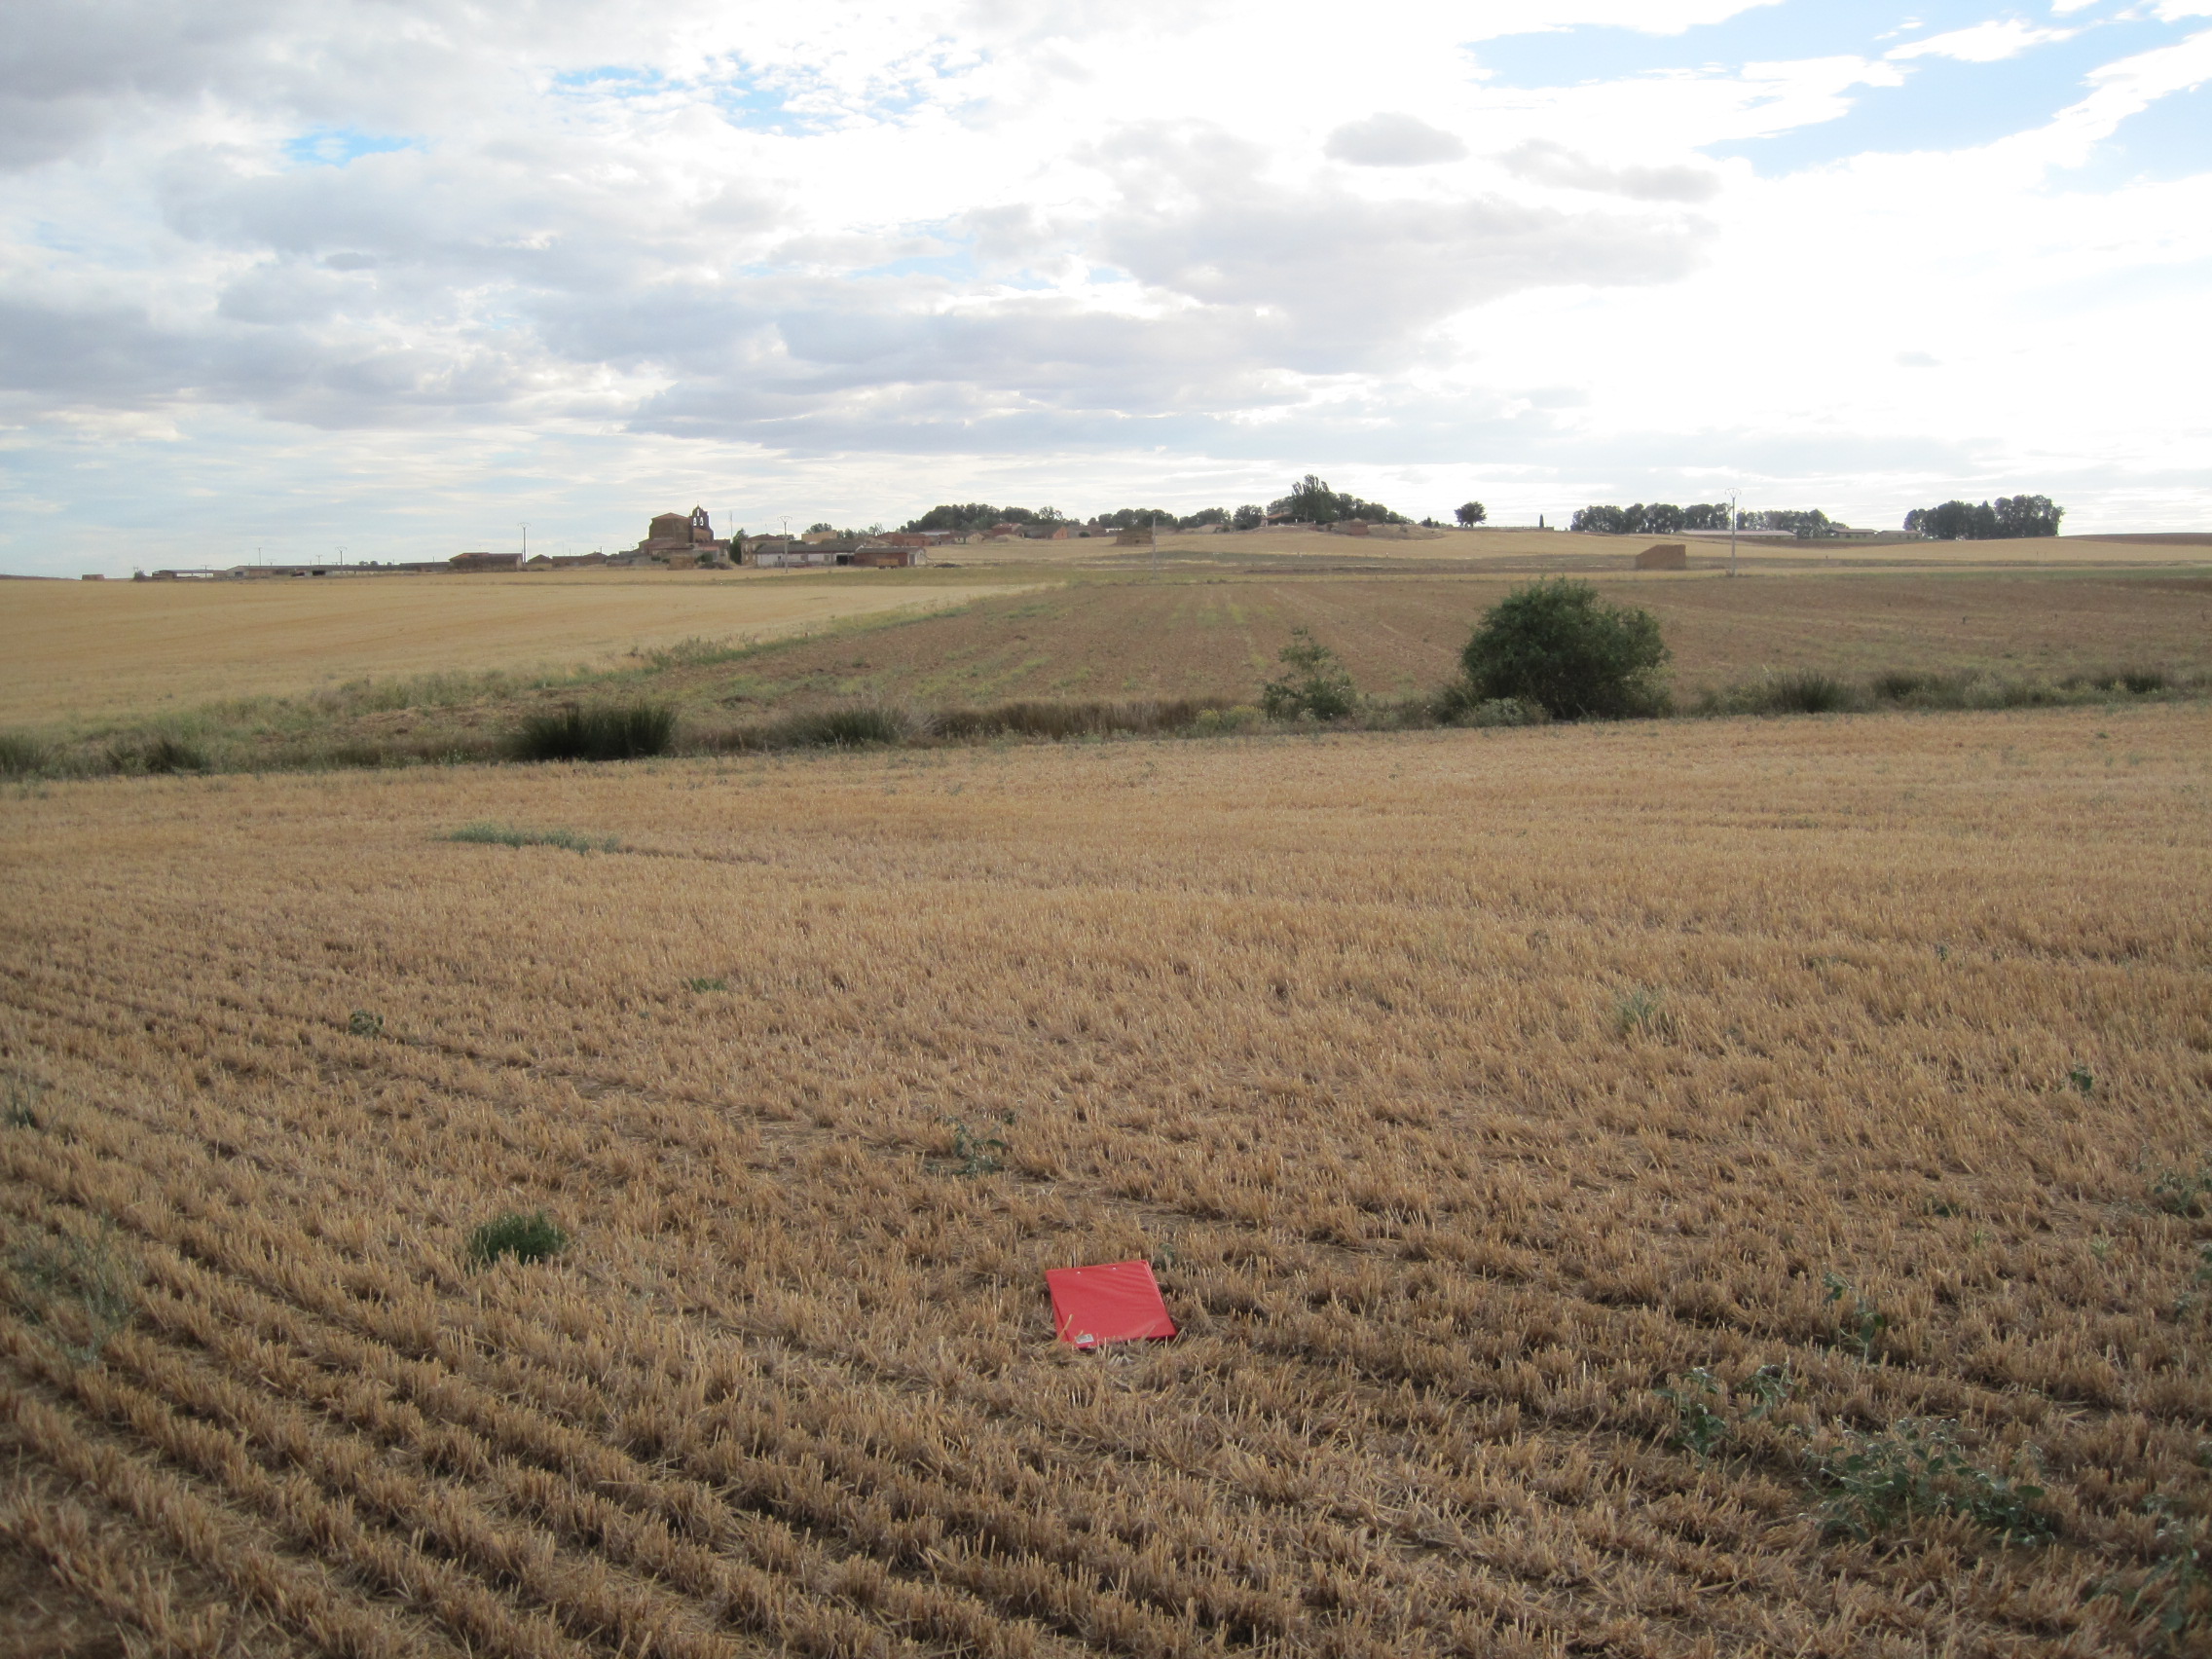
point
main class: Cropland
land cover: Barley
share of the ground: < 10 %
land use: Agriculture (excluding fallow land and kitchen gardens)
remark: Harvested field
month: July
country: ES
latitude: 41.9251
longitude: -5.4119
